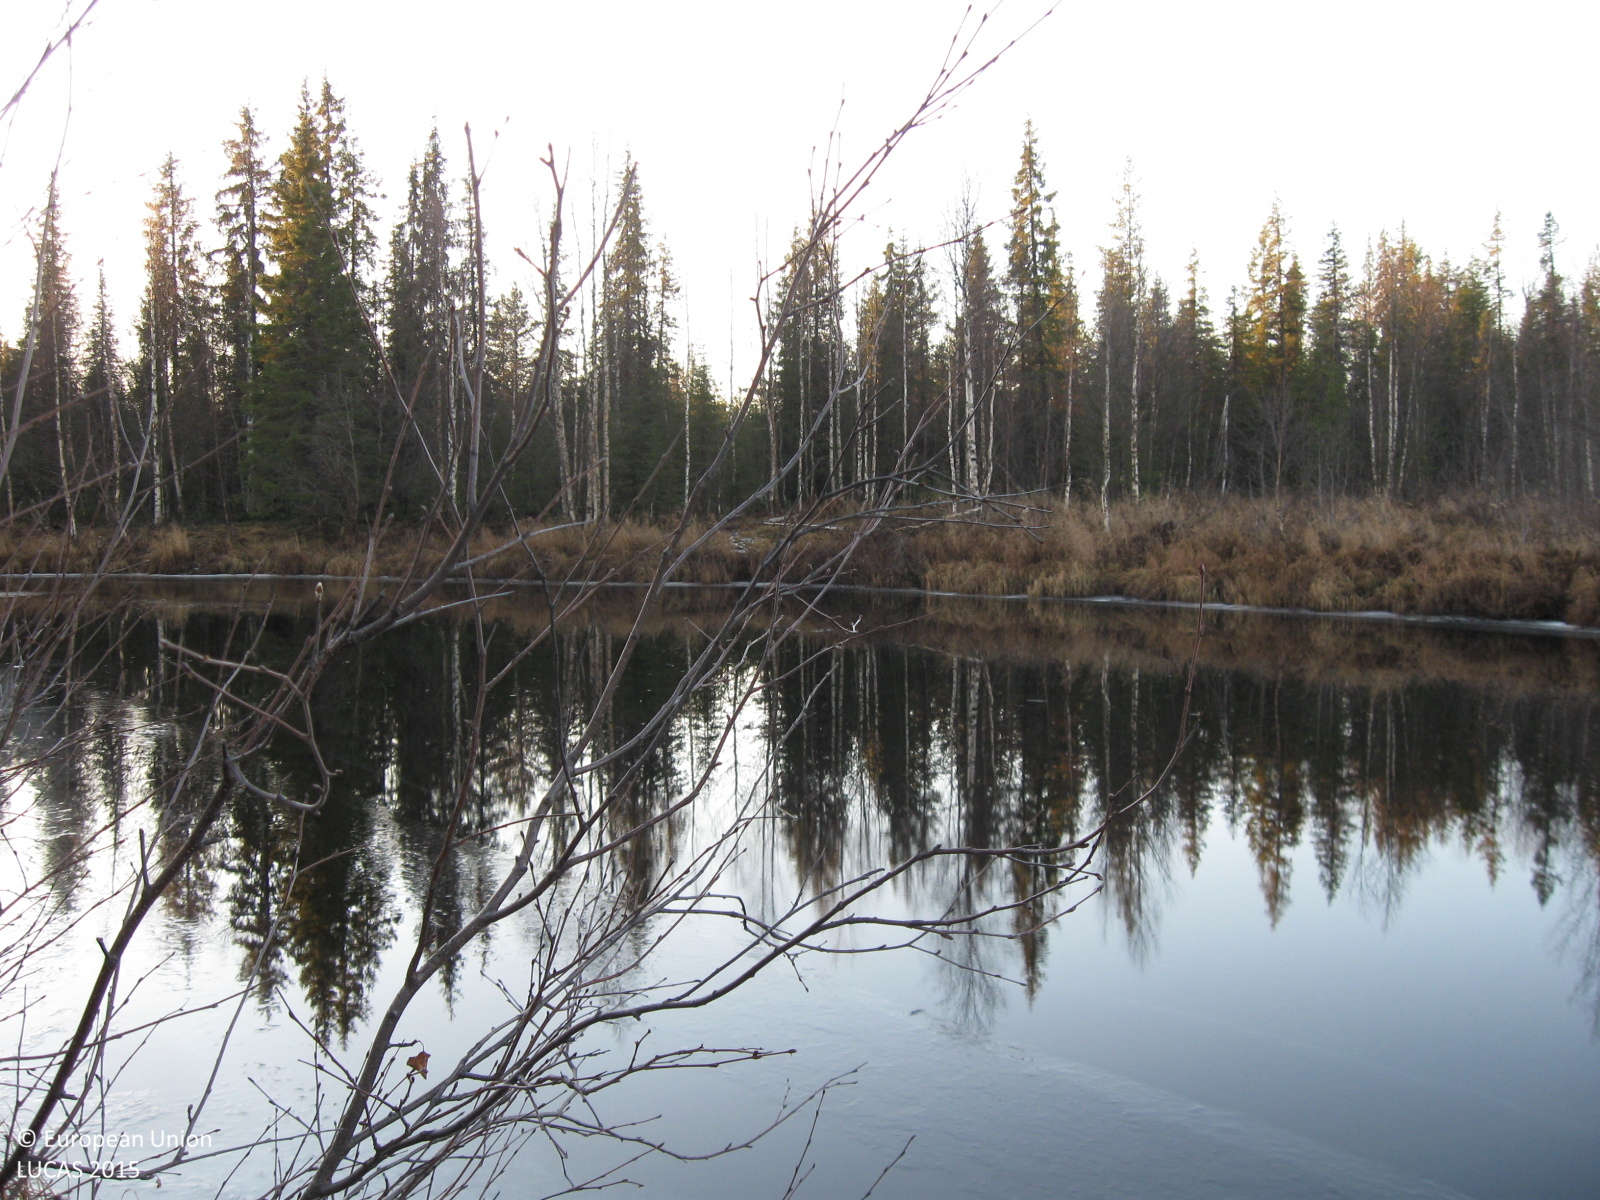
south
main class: Grassland
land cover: Grassland with sparse tree/shrub cover
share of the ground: > 75 %
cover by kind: herbaceous plants 90 %, broadleaved forest trees 5 %, shrubs 5 %
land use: Semi-natural and natural areas not in use
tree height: < 5 m
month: November
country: SE
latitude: 66.2136
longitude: 20.6476
